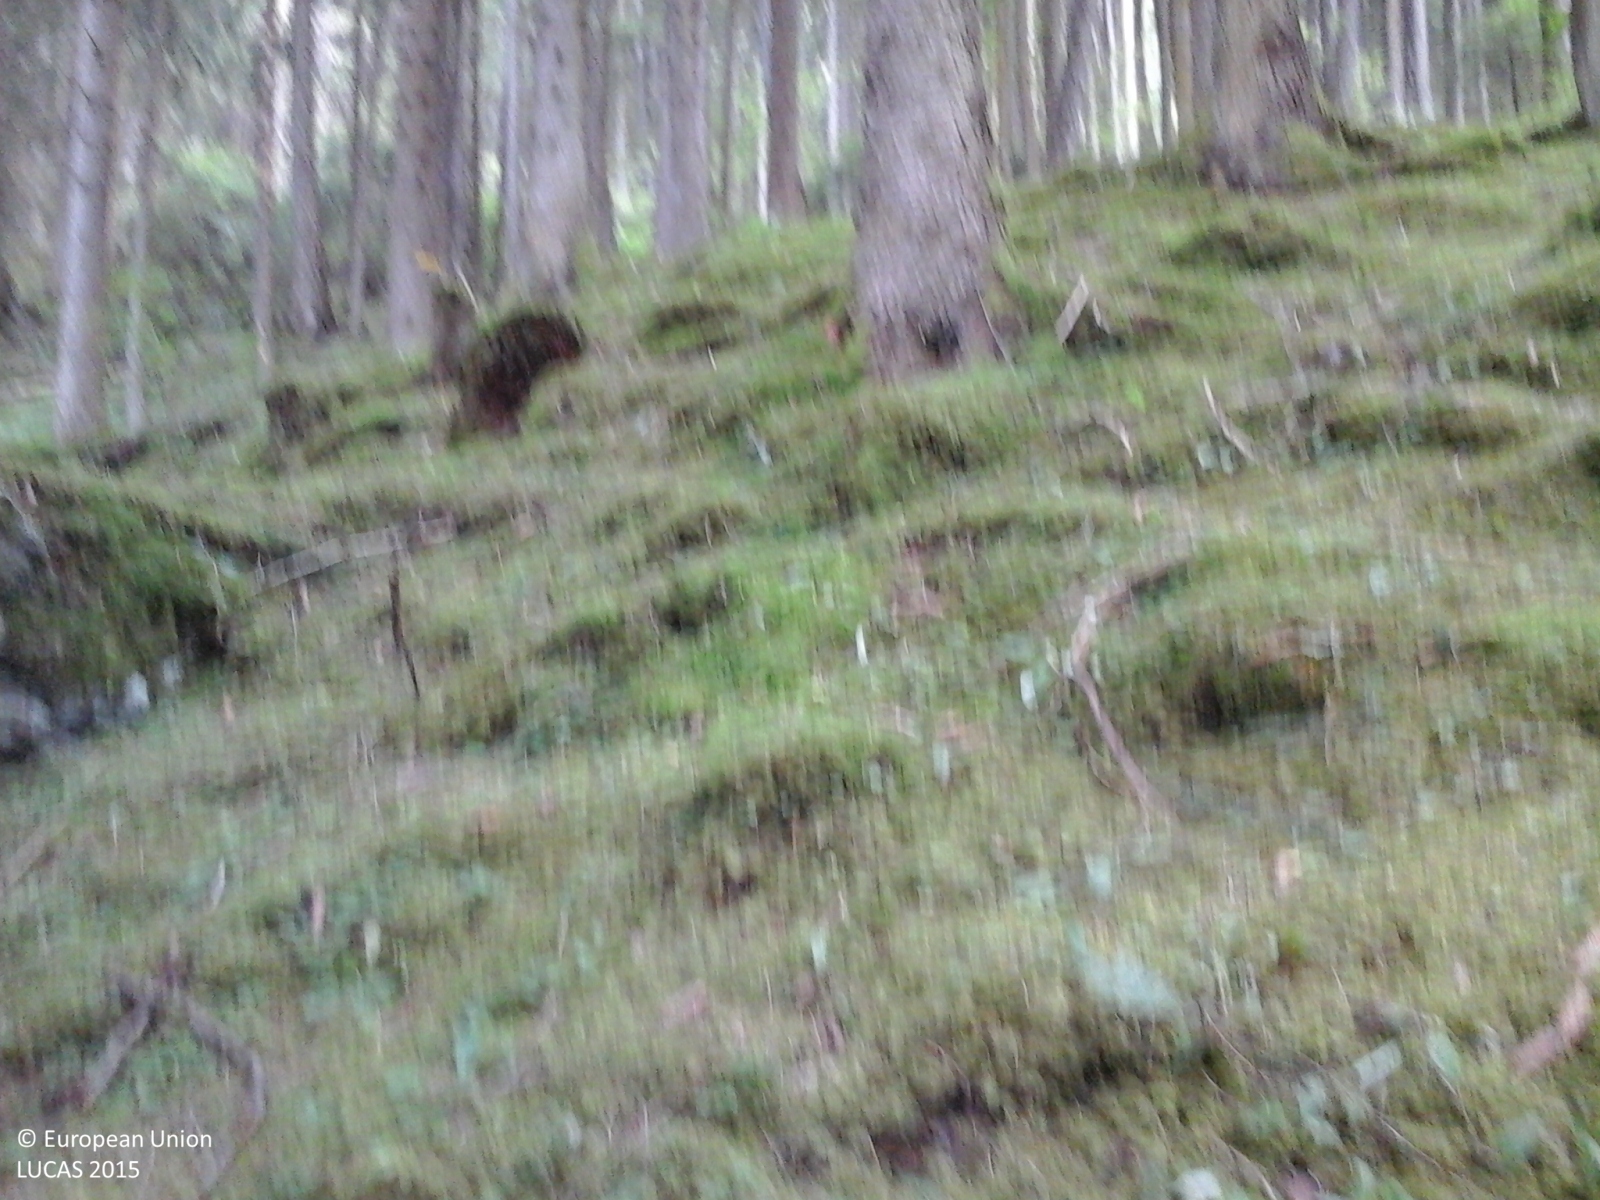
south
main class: Woodland
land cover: Spruce dominated coniferous woodland
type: alpine coniferous forest
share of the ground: > 75 %
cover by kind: coniferous forest trees 100 %
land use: Forestry
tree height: > 5 m
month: July
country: IT
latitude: 46.8050
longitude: 11.7671
